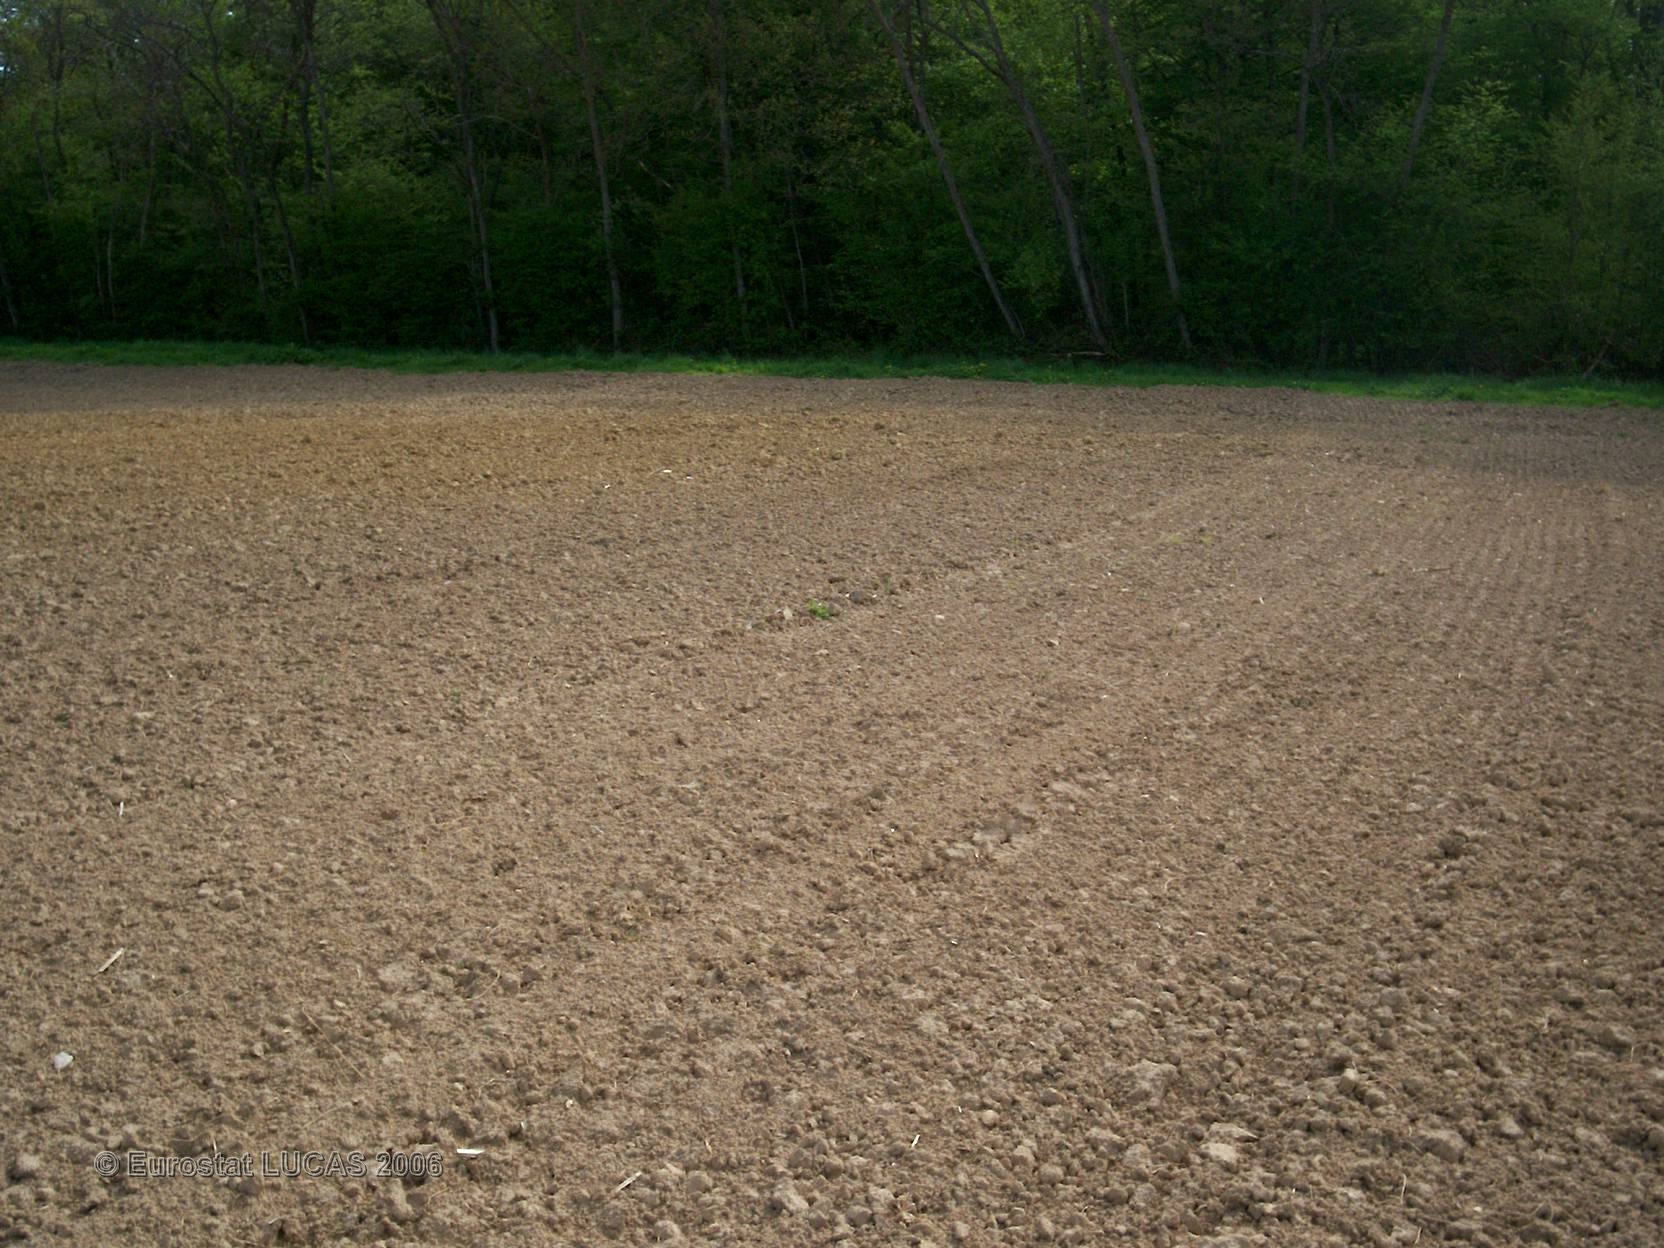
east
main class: Cropland
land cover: Other leguminous and mixtures for fodder
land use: Agriculture (excluding fallow land and kitchen gardens)
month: May
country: FR
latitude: 48.0436
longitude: 4.0275
